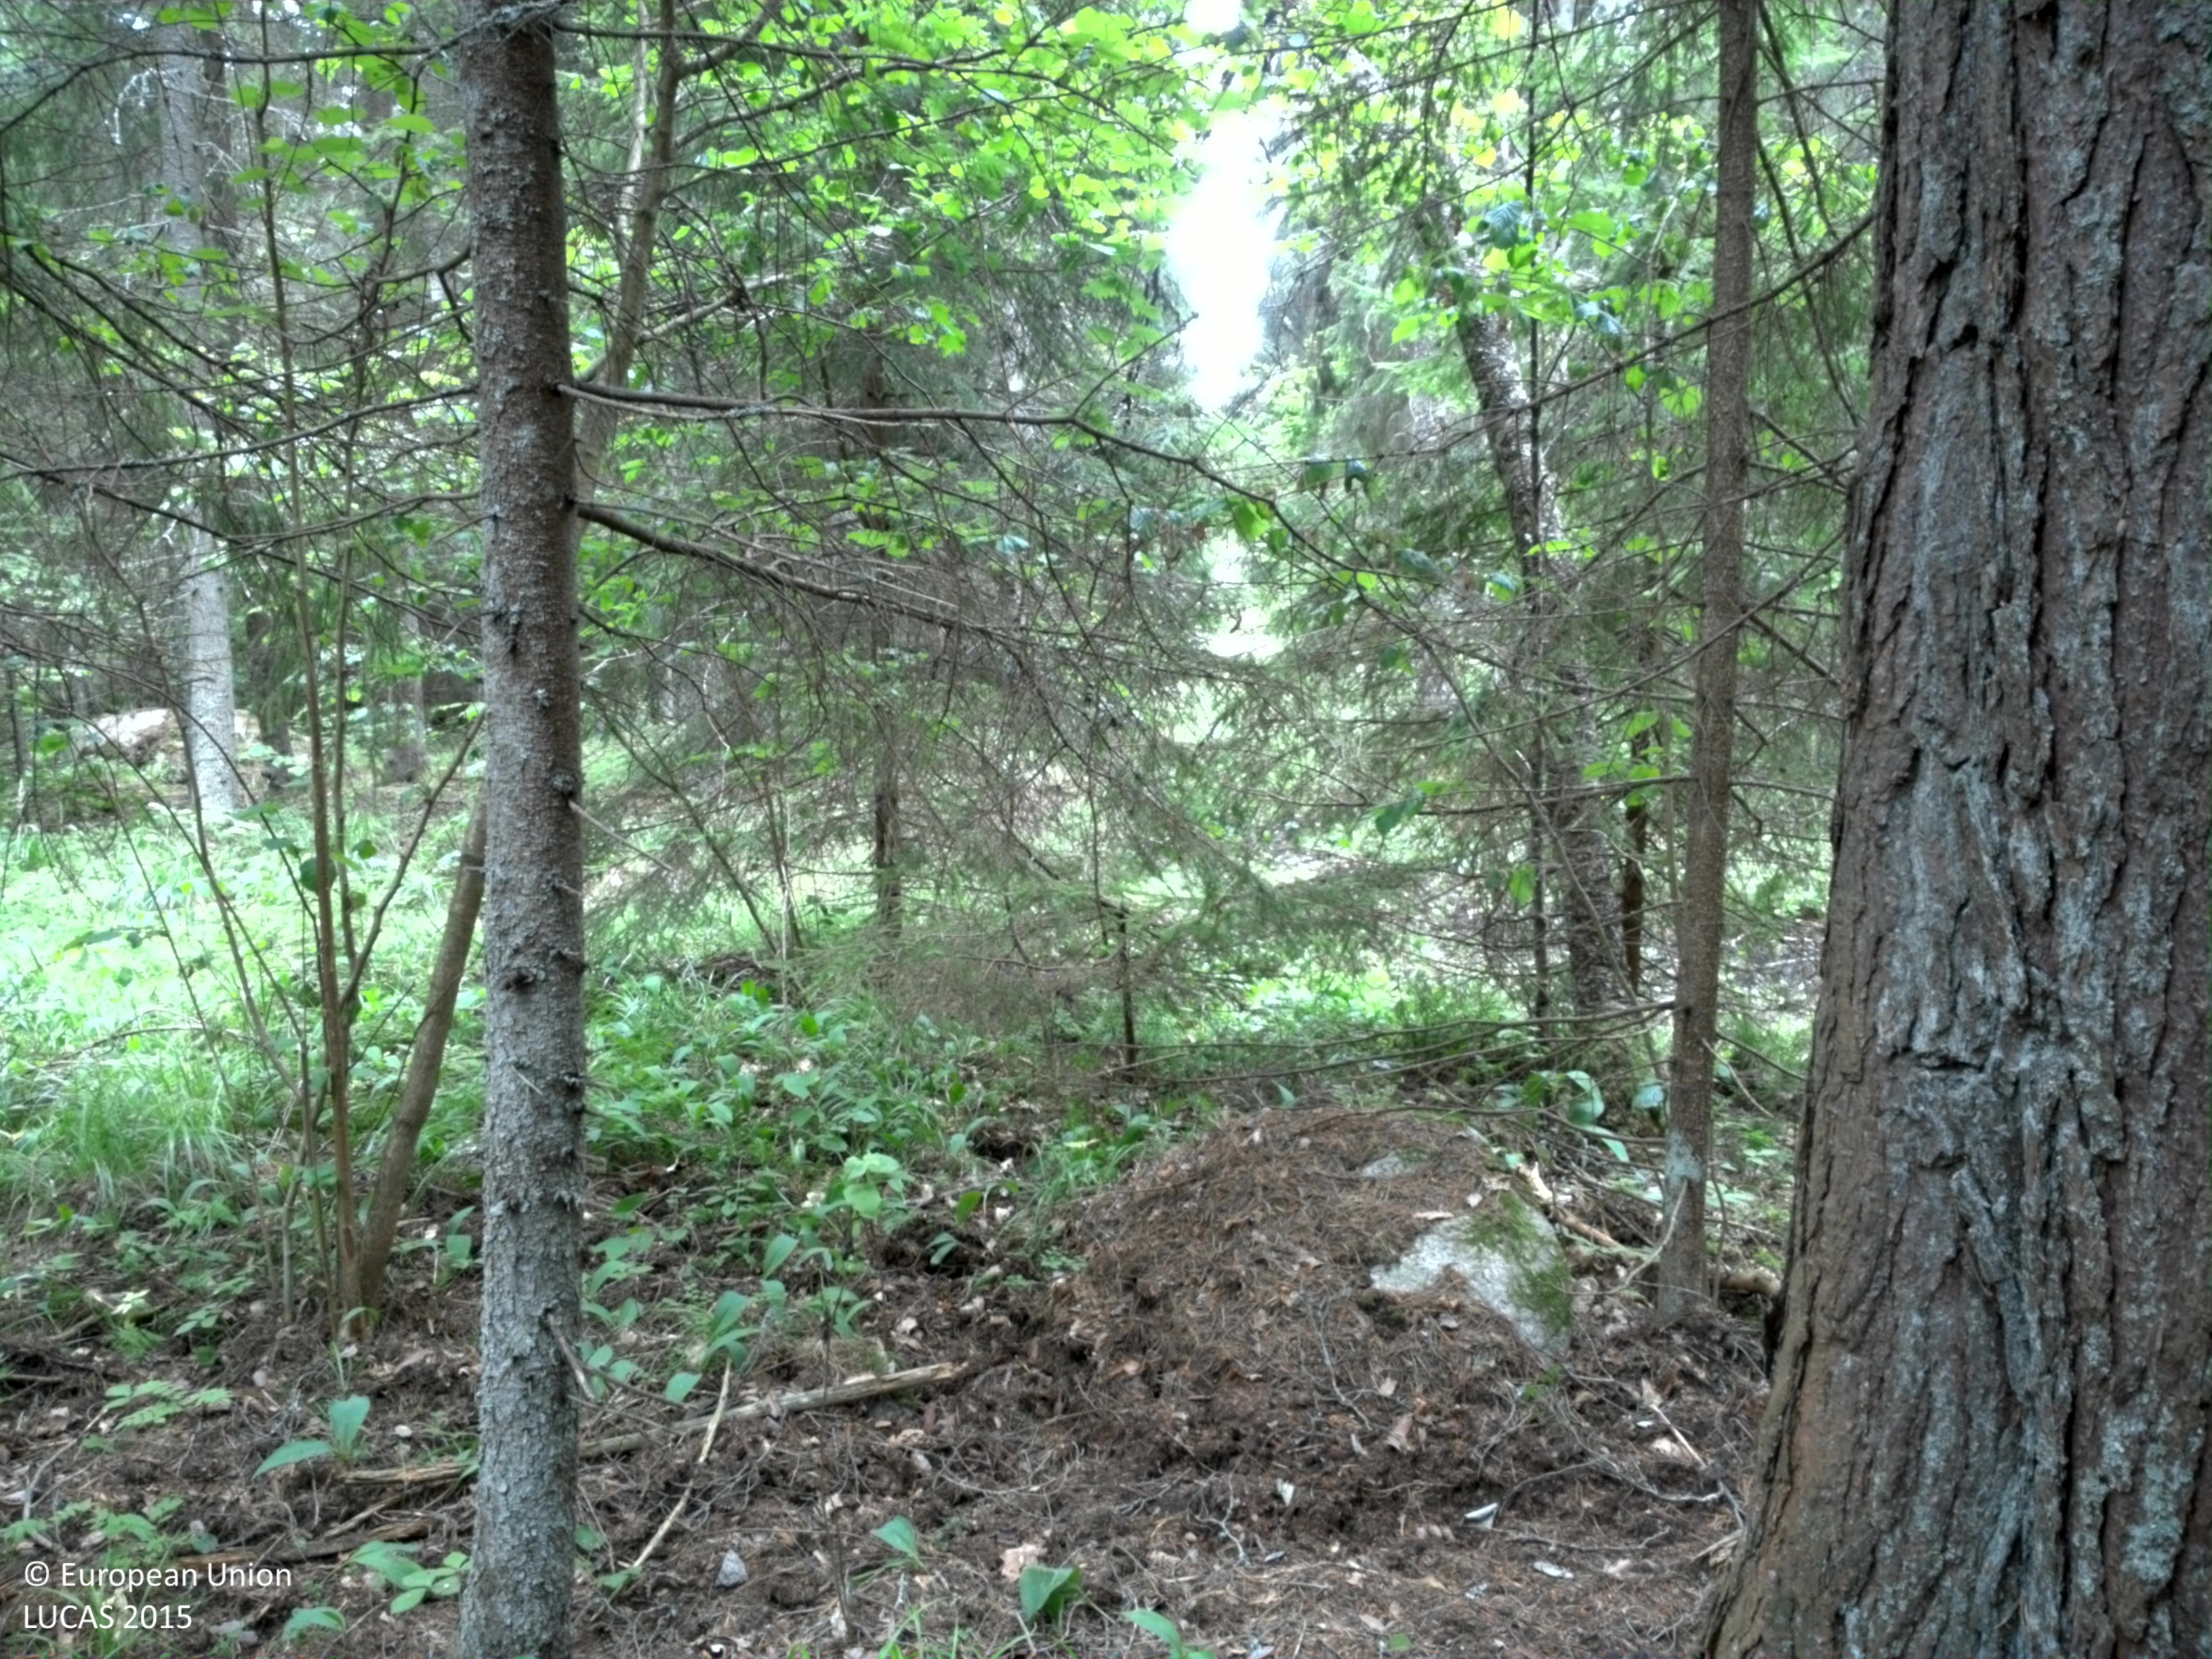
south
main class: Woodland
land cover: Spruce dominated coniferous woodland
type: boreal forest
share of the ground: > 75 %
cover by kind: coniferous forest trees 65 %, broadleaved forest trees 10 %, shrubs 10 %, herbaceous plants 10 %, lichens and mosses 5 %
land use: Forestry
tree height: > 5 m
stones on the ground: < 10 %
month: July
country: SE
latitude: 59.8328
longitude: 18.5083
